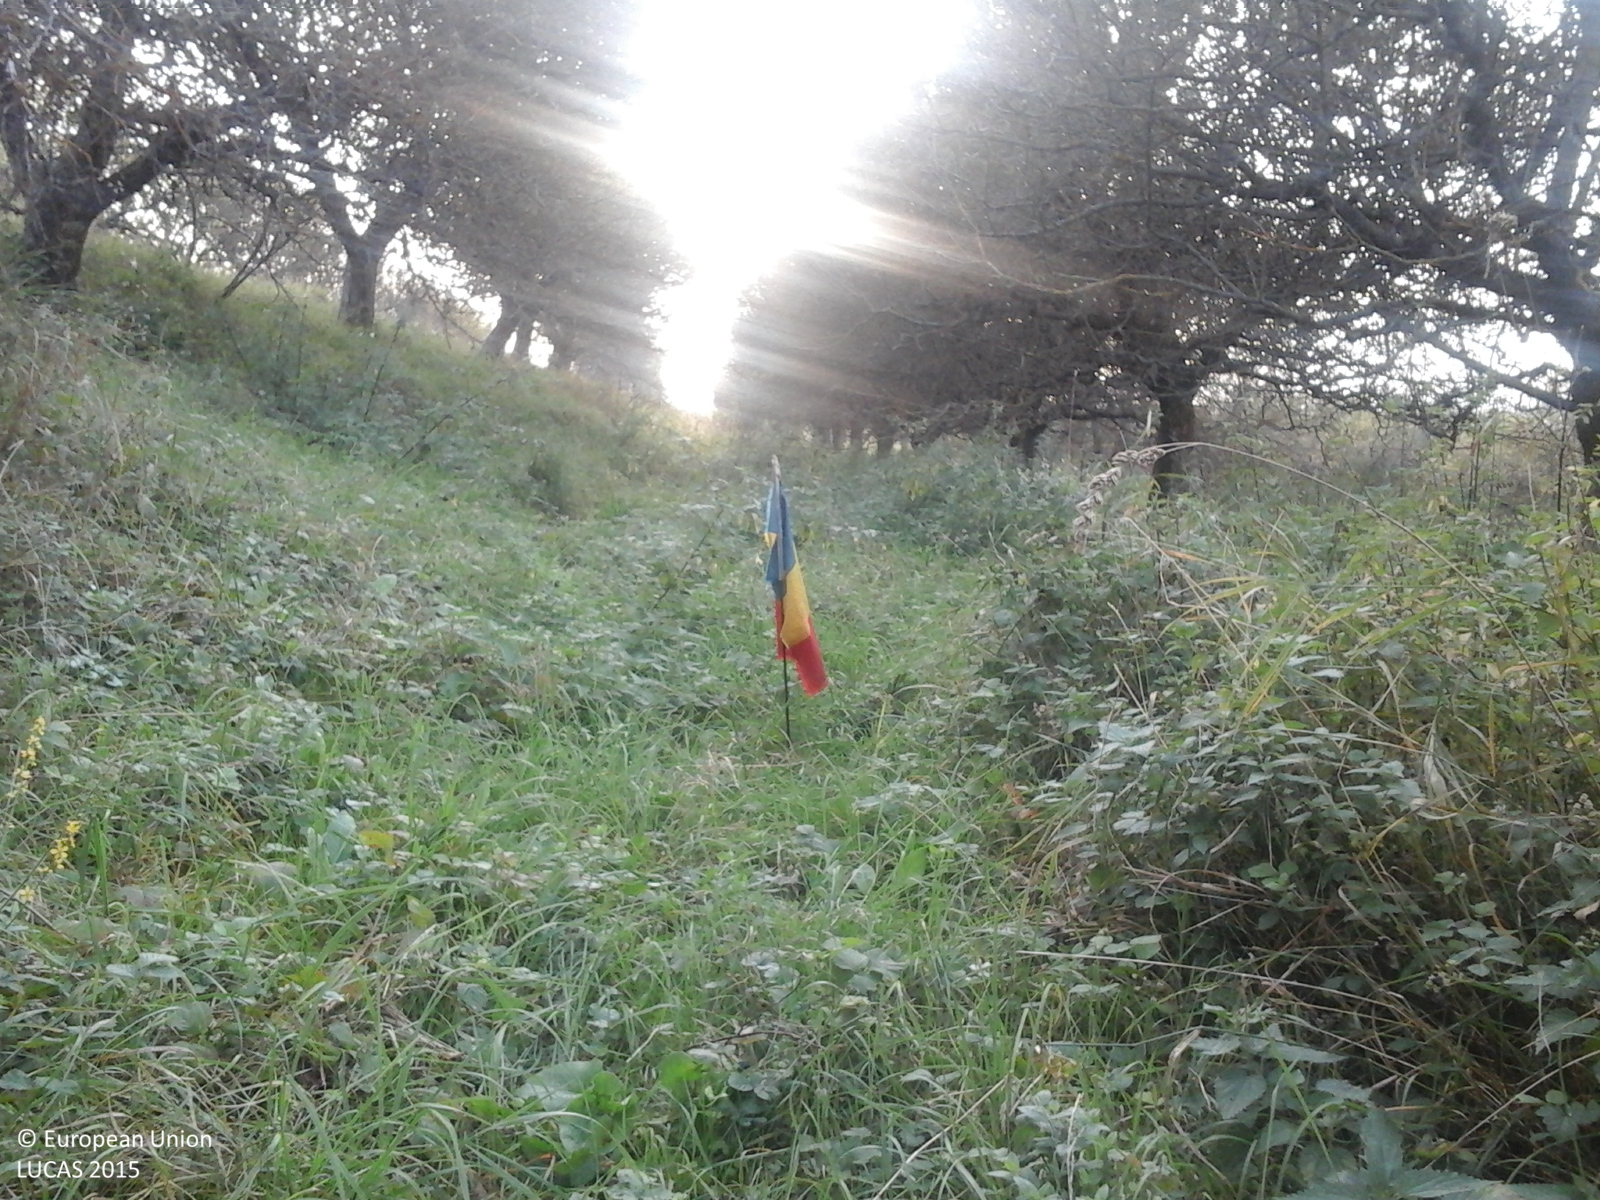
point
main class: Cropland
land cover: Apple fruit
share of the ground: > 75 %
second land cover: Grassland without tree/shrub cover
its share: > 75 %
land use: Agriculture (excluding fallow land and kitchen gardens)
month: September
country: RO
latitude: 46.7351
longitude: 23.6160
